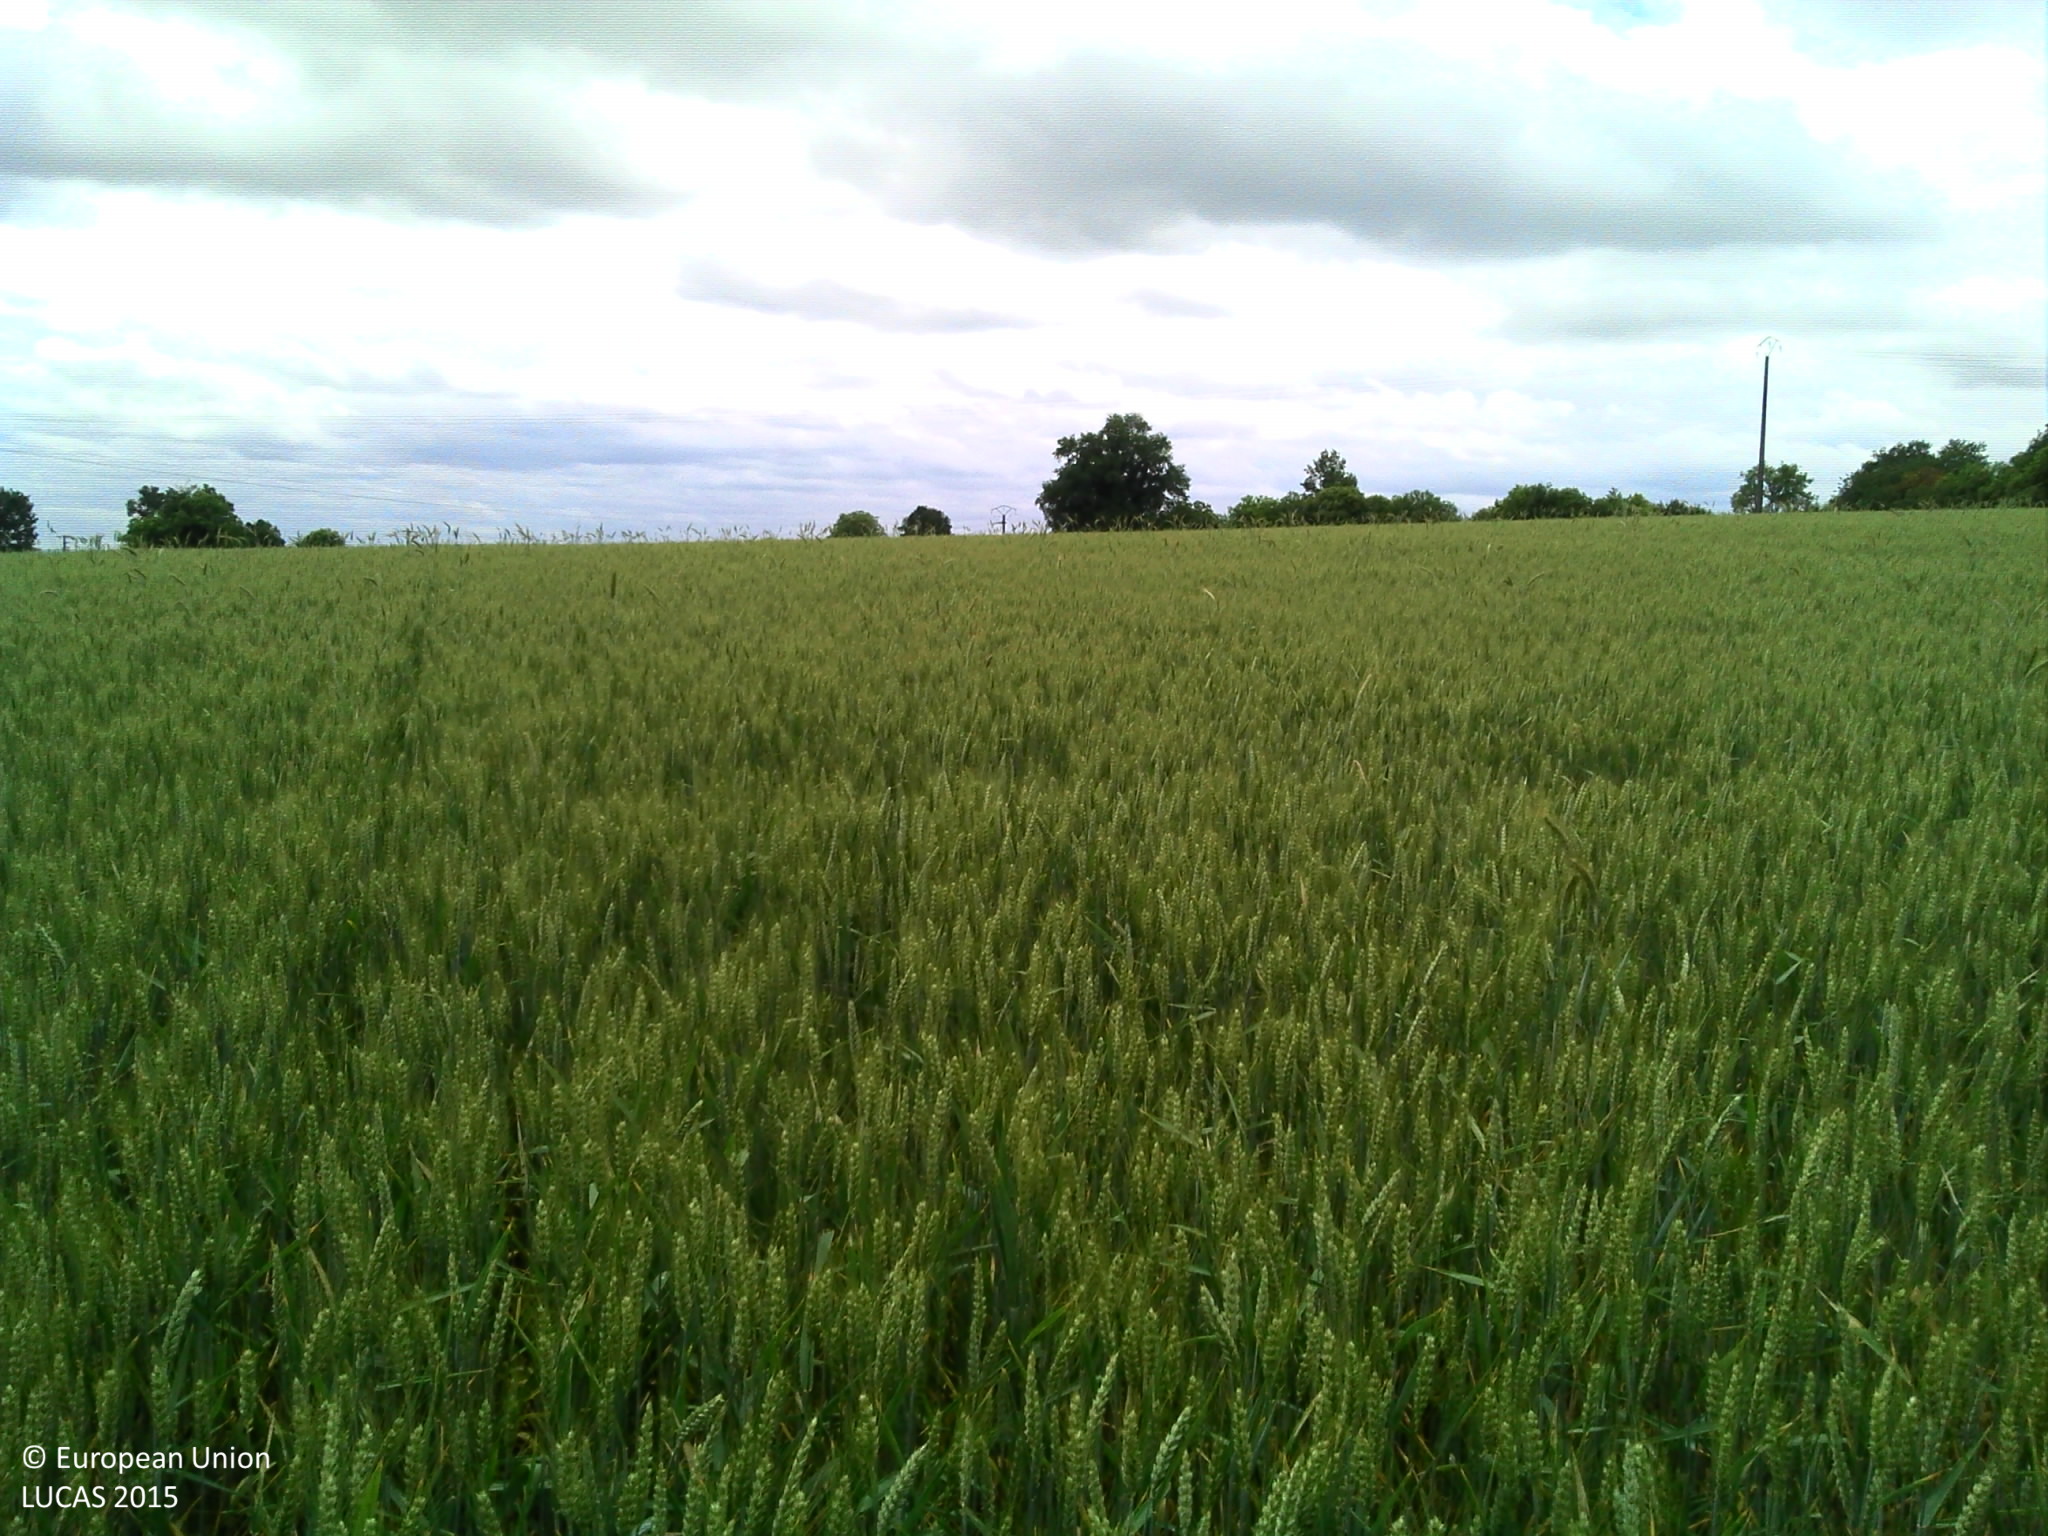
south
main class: Cropland
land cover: Common wheat
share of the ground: > 75 %
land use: Agriculture (excluding fallow land and kitchen gardens)
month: June
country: FR
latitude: 46.0058
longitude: 0.3628
